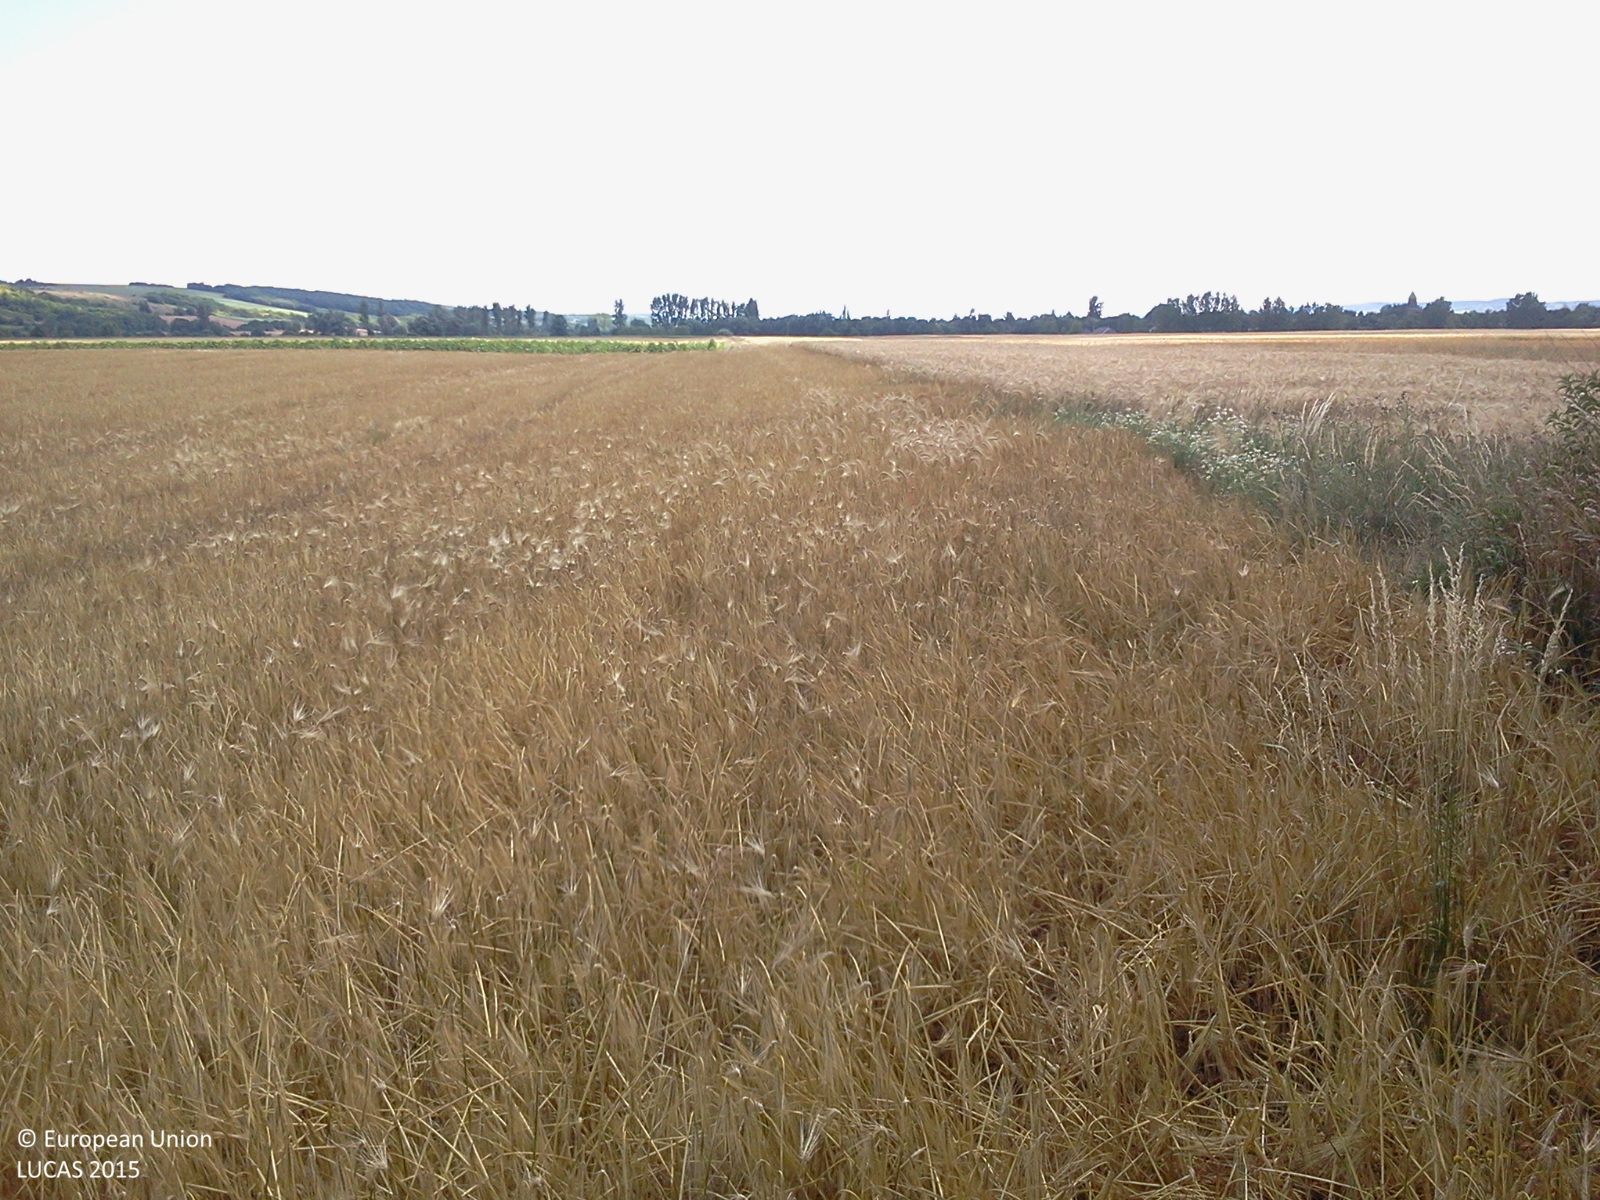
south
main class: Cropland
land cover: Barley
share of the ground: > 75 %
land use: Agriculture (excluding fallow land and kitchen gardens)
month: June
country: HU
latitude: 46.9279
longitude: 17.1098
